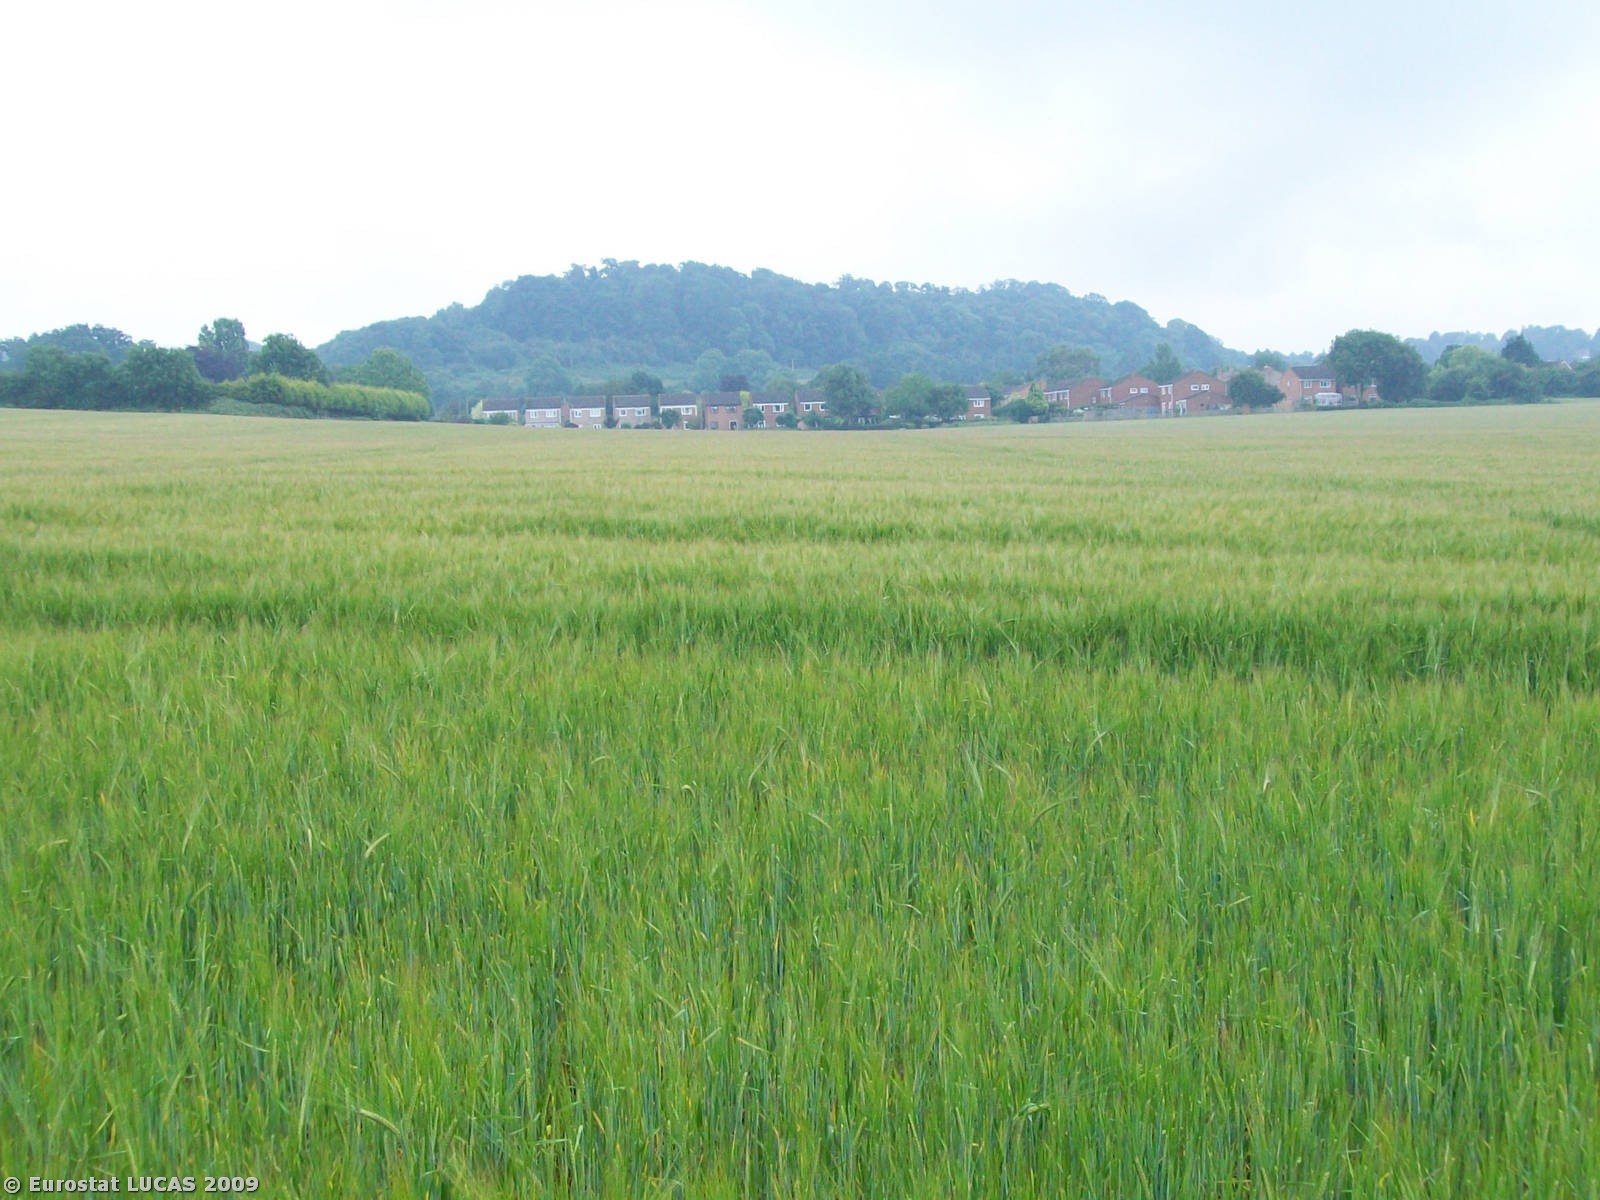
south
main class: Cropland
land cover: Barley
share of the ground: > 75 %
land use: Agriculture (excluding fallow land and kitchen gardens)
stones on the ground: < 10 %
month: June
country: GB
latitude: 51.2514
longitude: -2.2260
